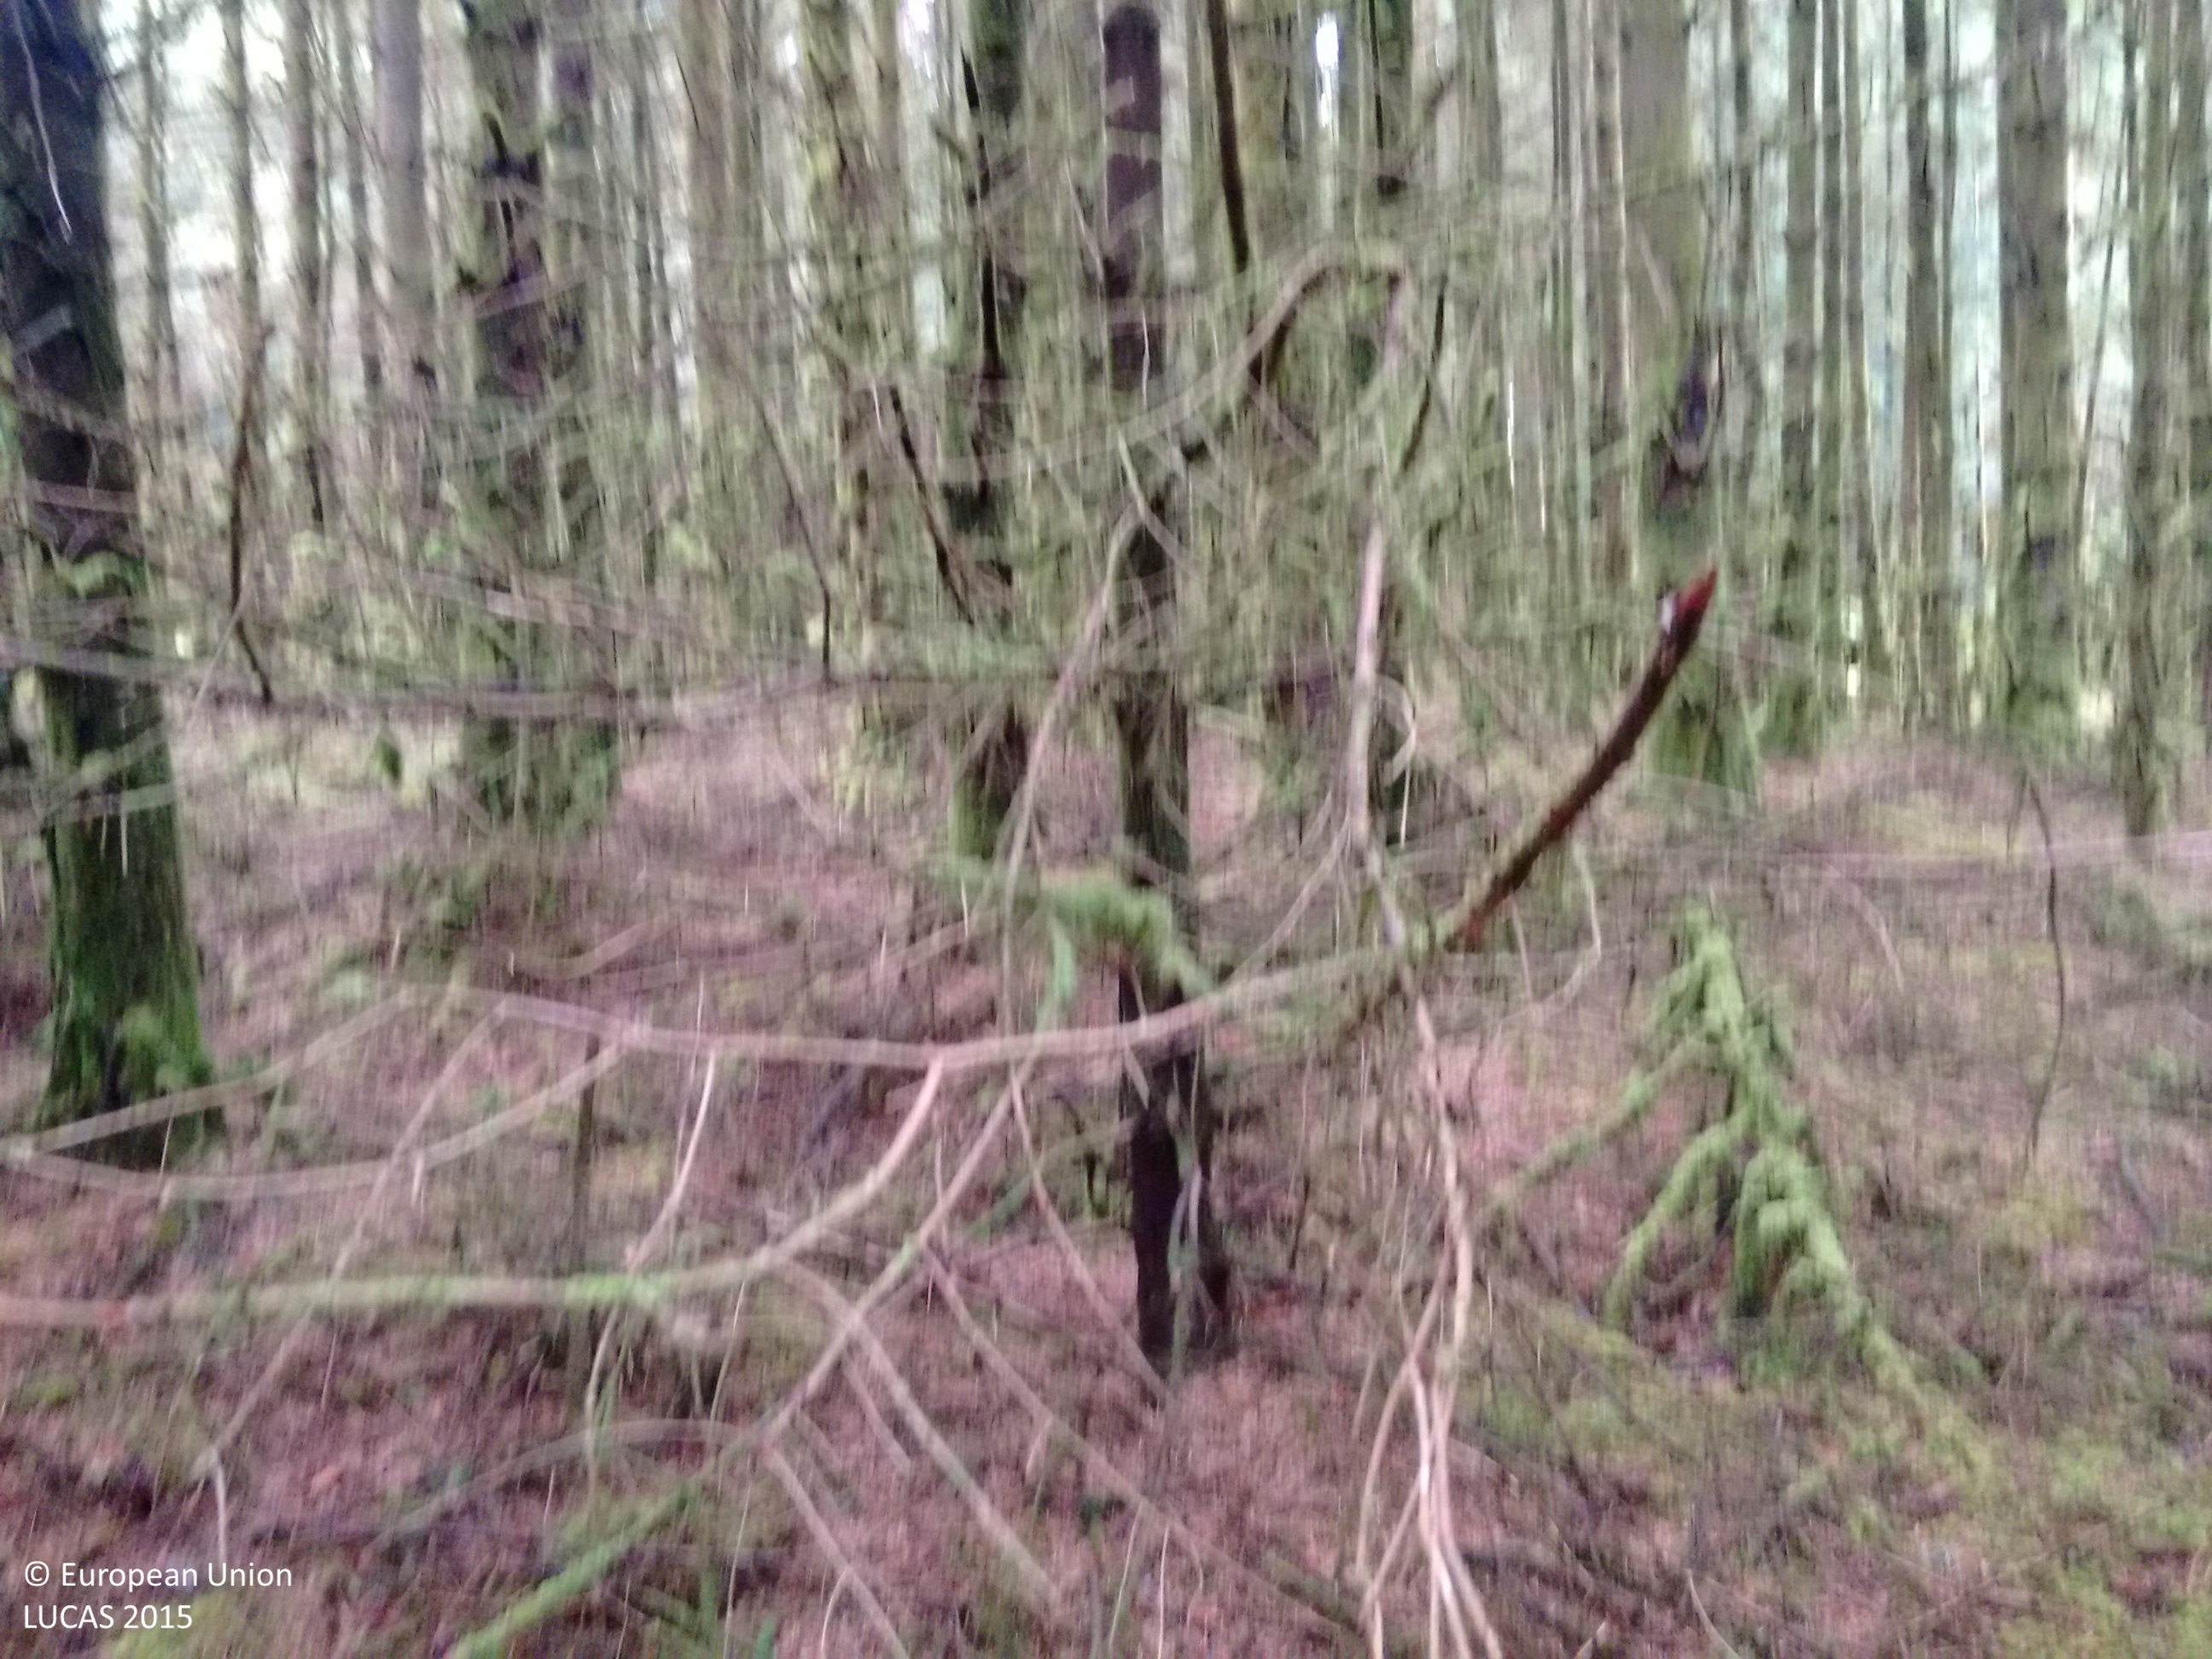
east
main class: Woodland
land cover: Spruce dominated coniferous woodland
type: exotic forest
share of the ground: > 75 %
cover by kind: coniferous forest trees 100 %
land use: Forestry
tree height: > 5 m
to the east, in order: Spruce dominated coniferous woodland; Ditches and canals; Artificial constructions; Ditches and canals; Spontaneously vegetated surfaces
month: August
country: IE
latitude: 51.9092
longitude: -10.0093
